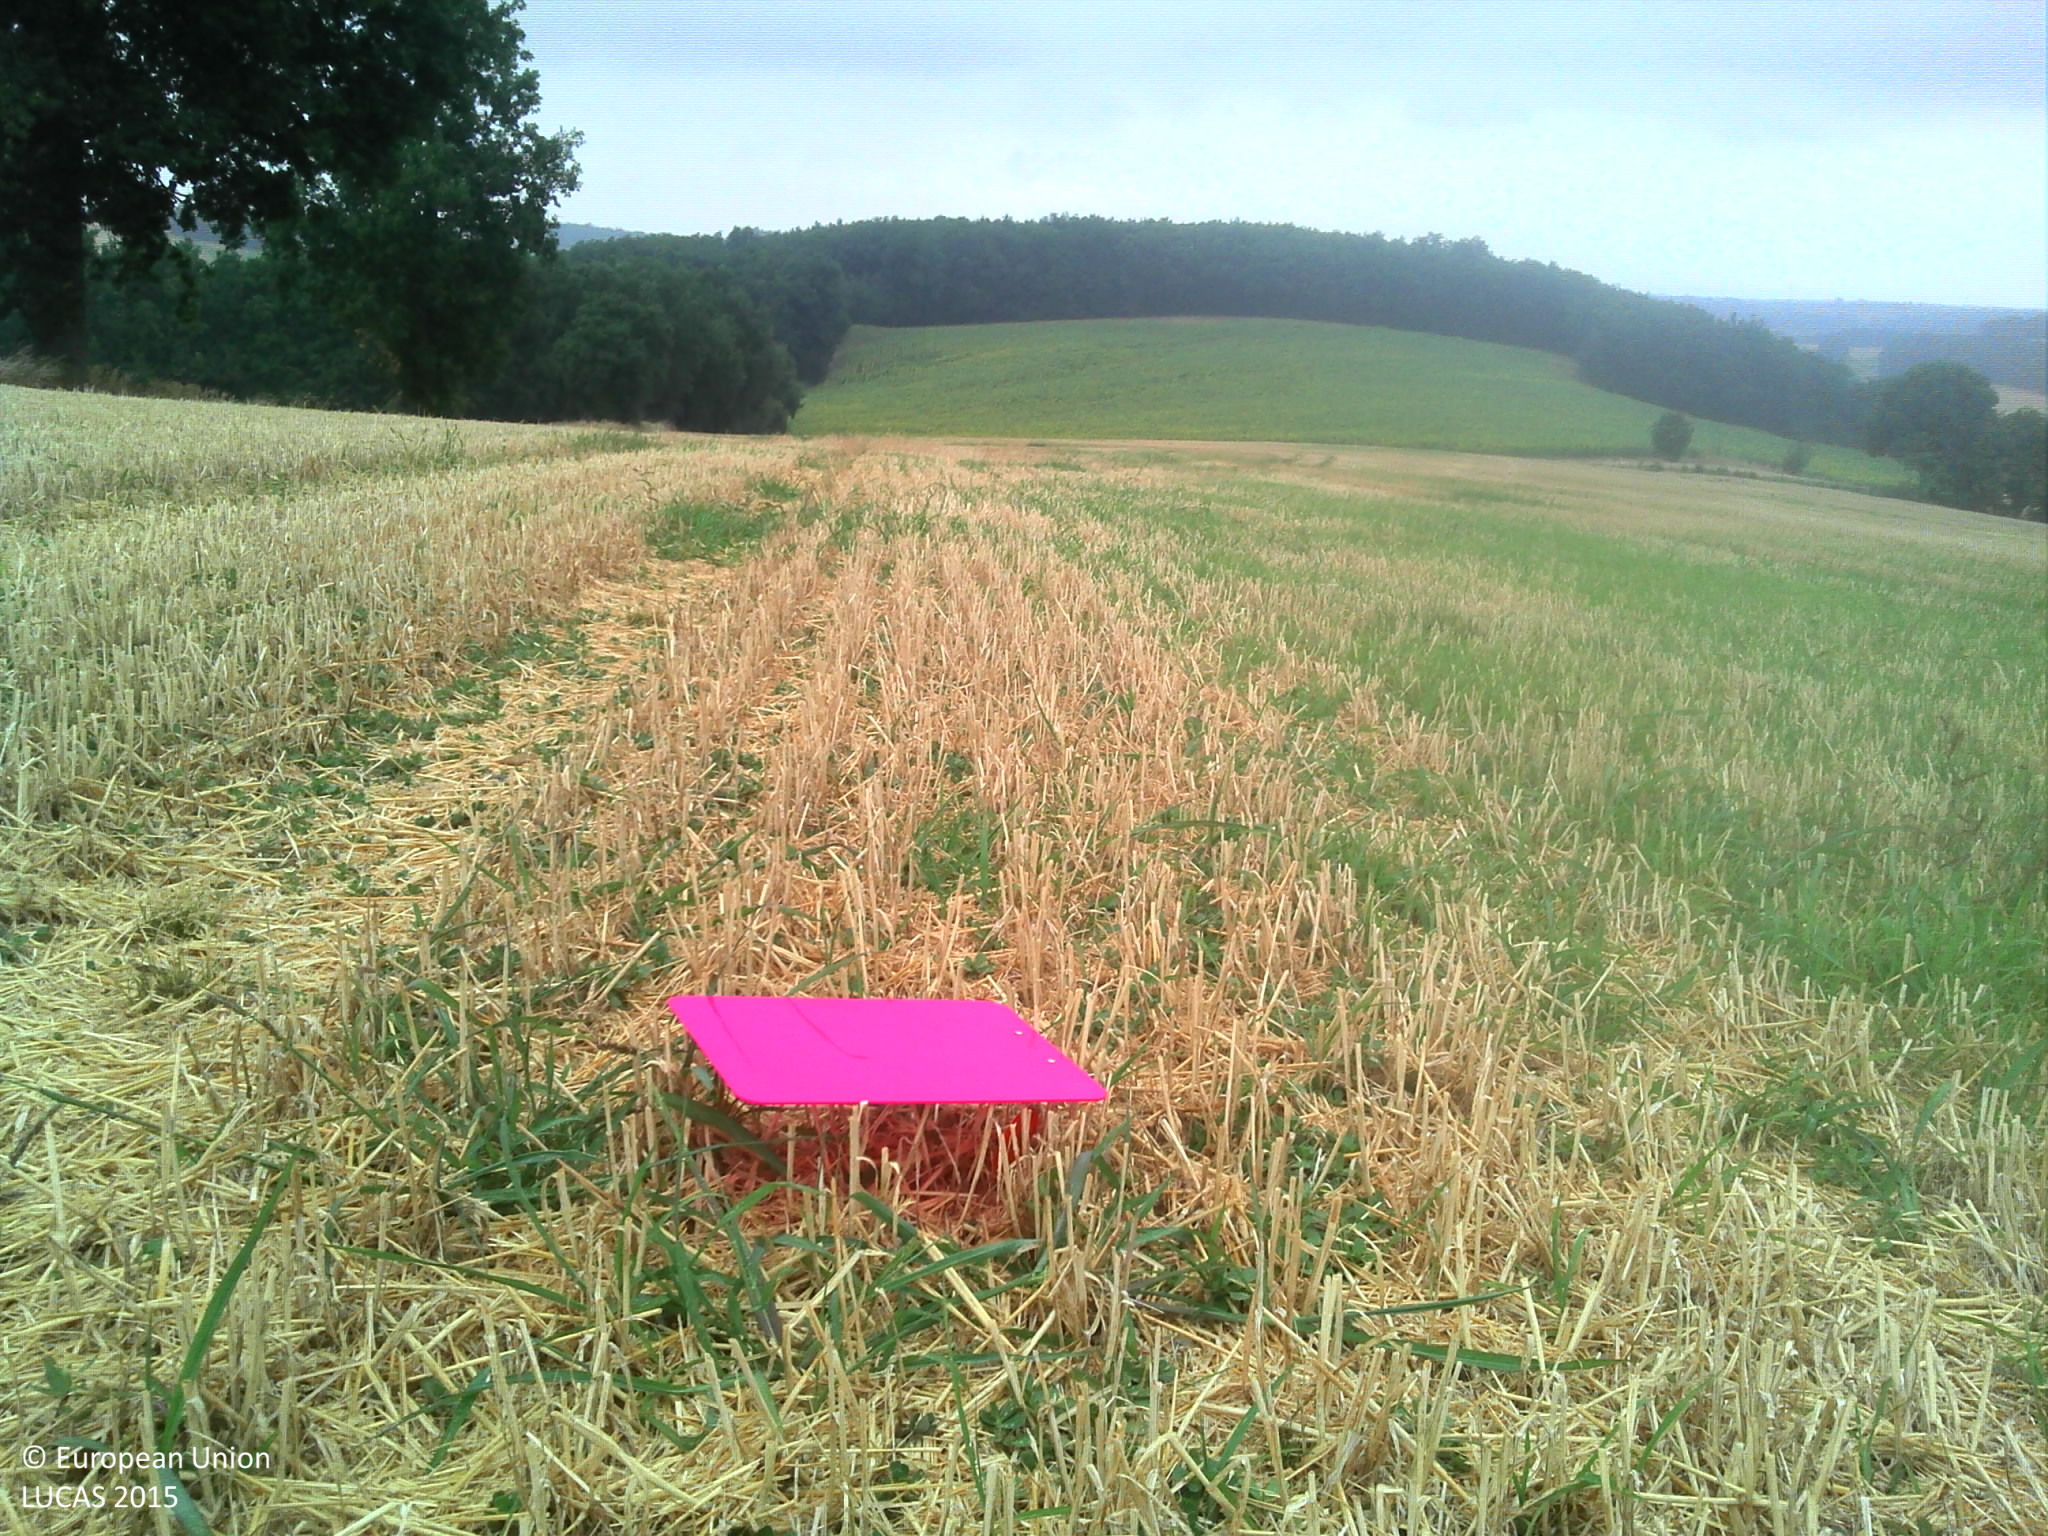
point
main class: Cropland
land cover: Common wheat
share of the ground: > 75 %
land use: Agriculture (excluding fallow land and kitchen gardens)
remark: Harvested field
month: July
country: FR
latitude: 43.9670
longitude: 0.8865
